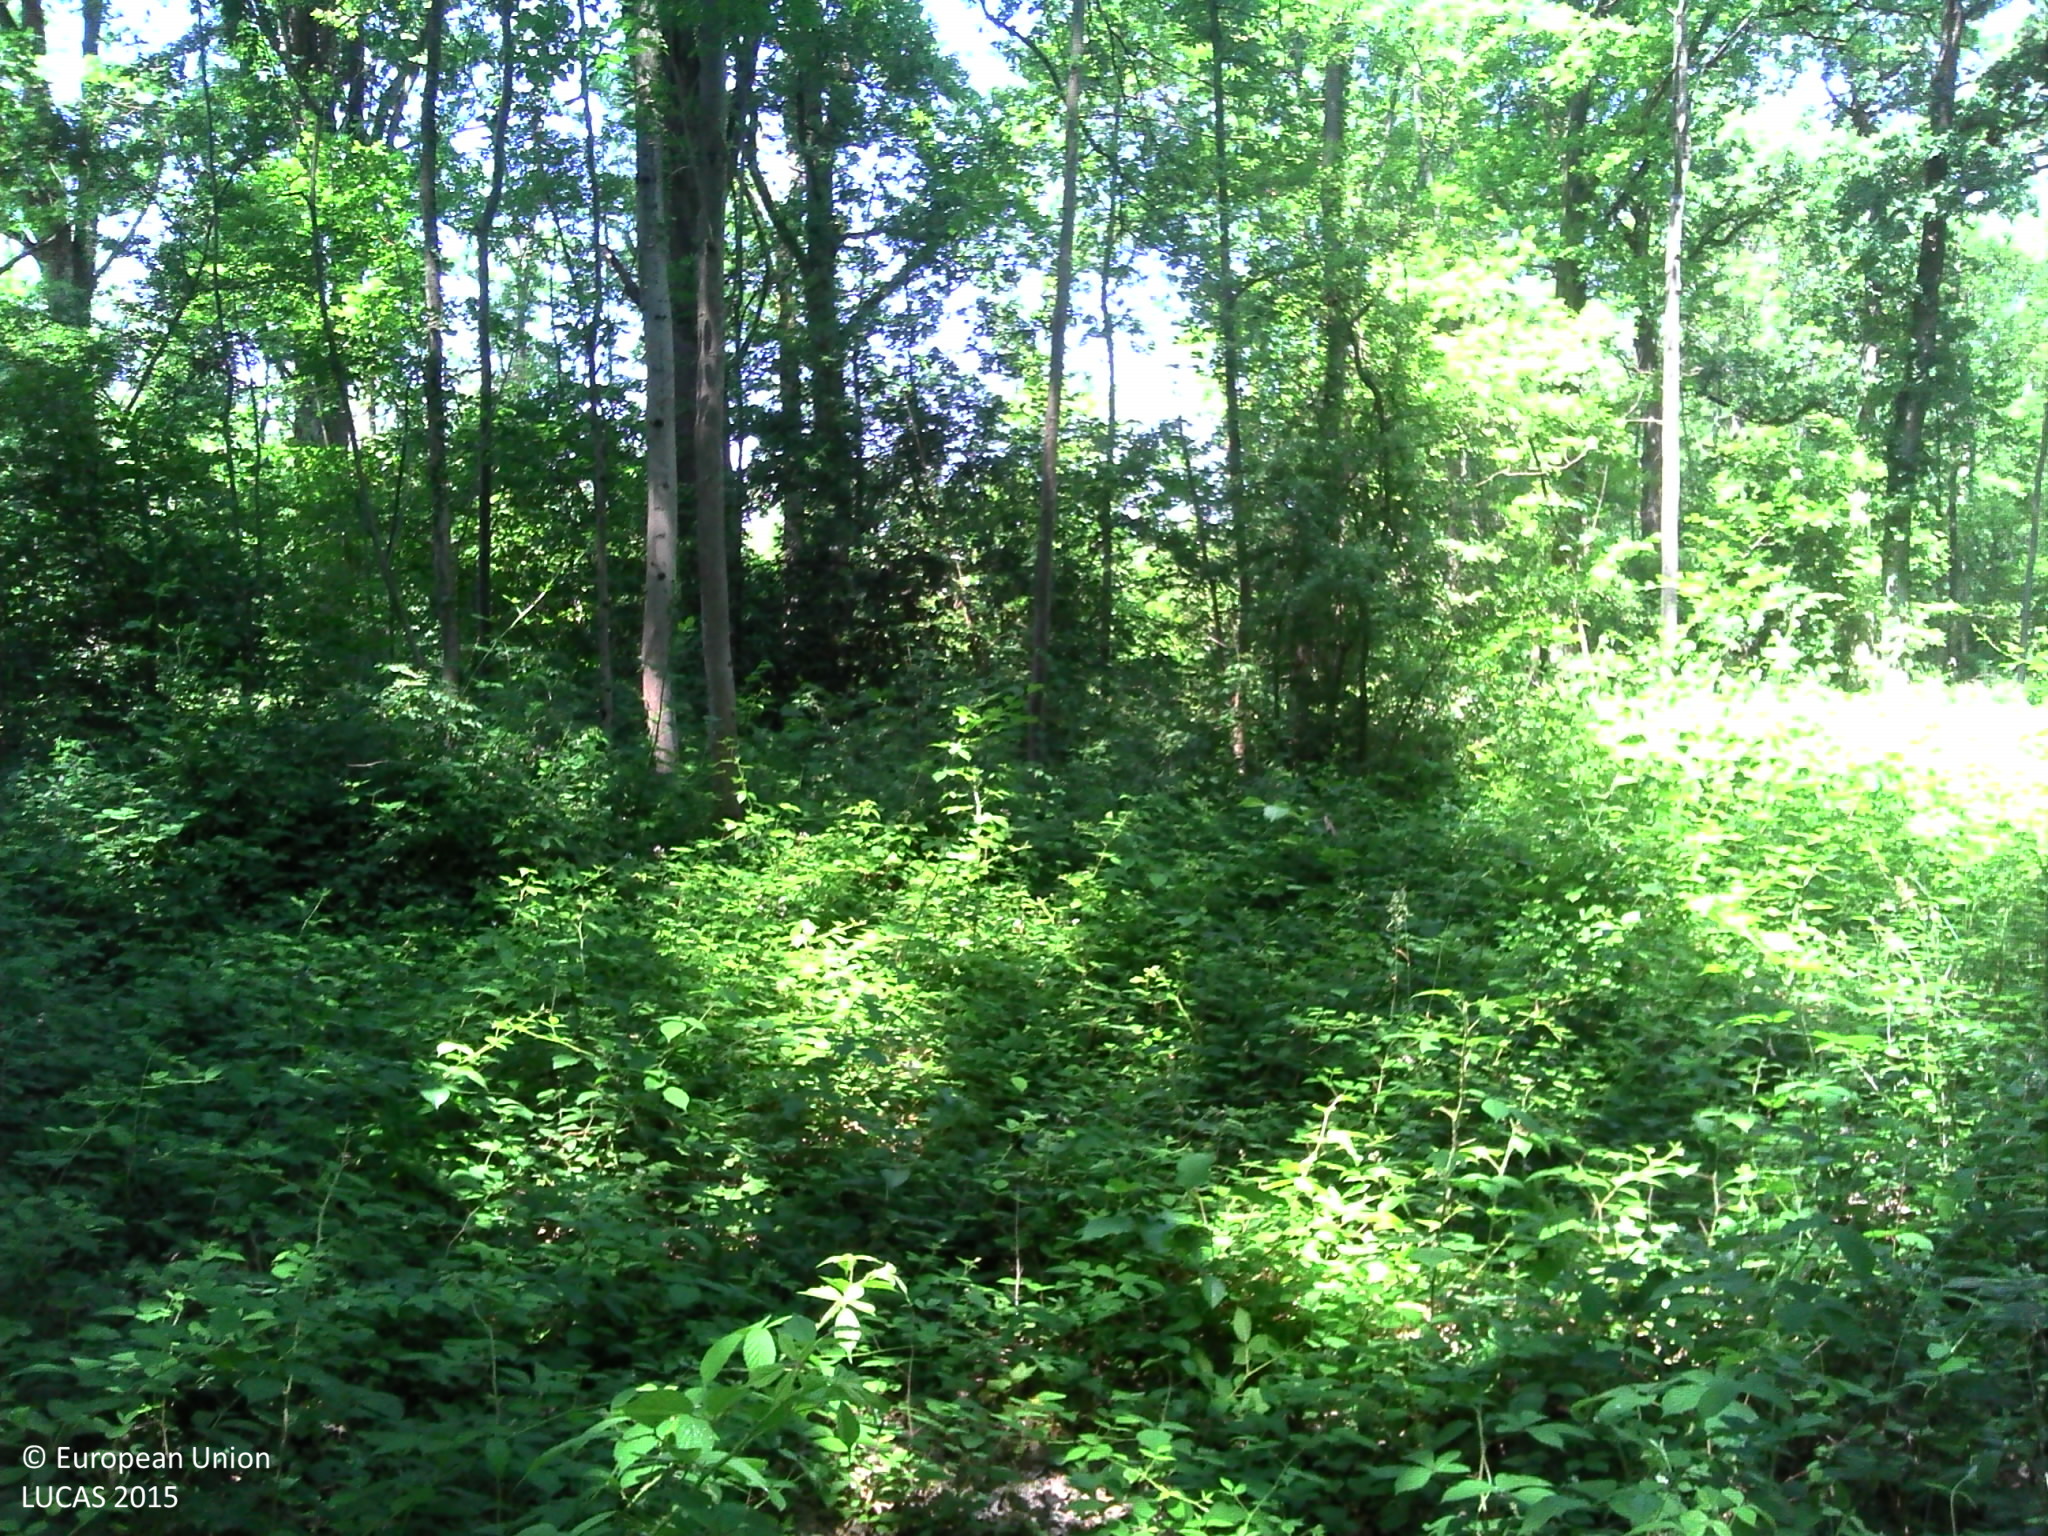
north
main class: Woodland
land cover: Broadleaved woodland
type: mesophytic deciduous forest
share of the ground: > 75 %
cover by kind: broadleaved forest trees 80 %, herbaceous plants 20 %
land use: Forestry
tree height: > 5 m
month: June
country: FR
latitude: 46.0298
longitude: 4.8740
